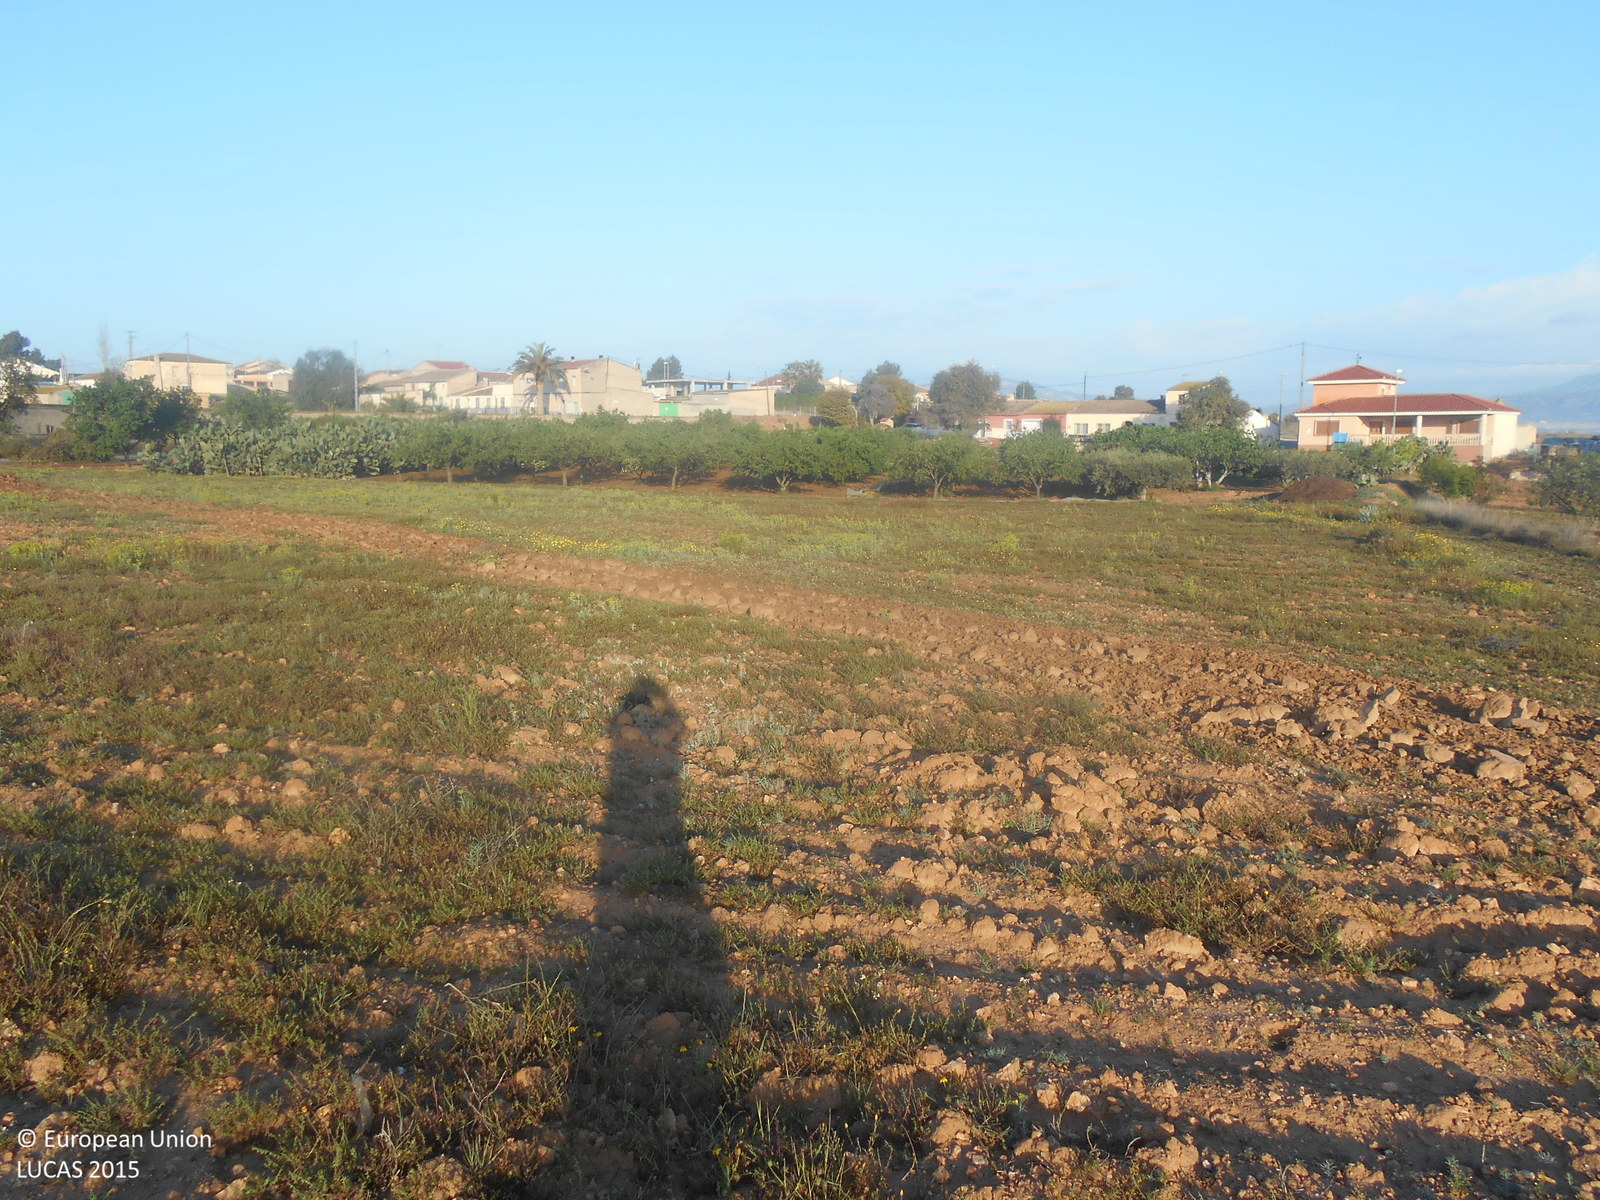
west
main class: Grassland
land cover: Spontaneously vegetated surfaces
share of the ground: 25 - 50 %
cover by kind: unconsolidated bare surface 70 %, herbaceous plants 30 %
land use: Fallow land
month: April
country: ES
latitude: 37.7176
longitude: -1.4057
